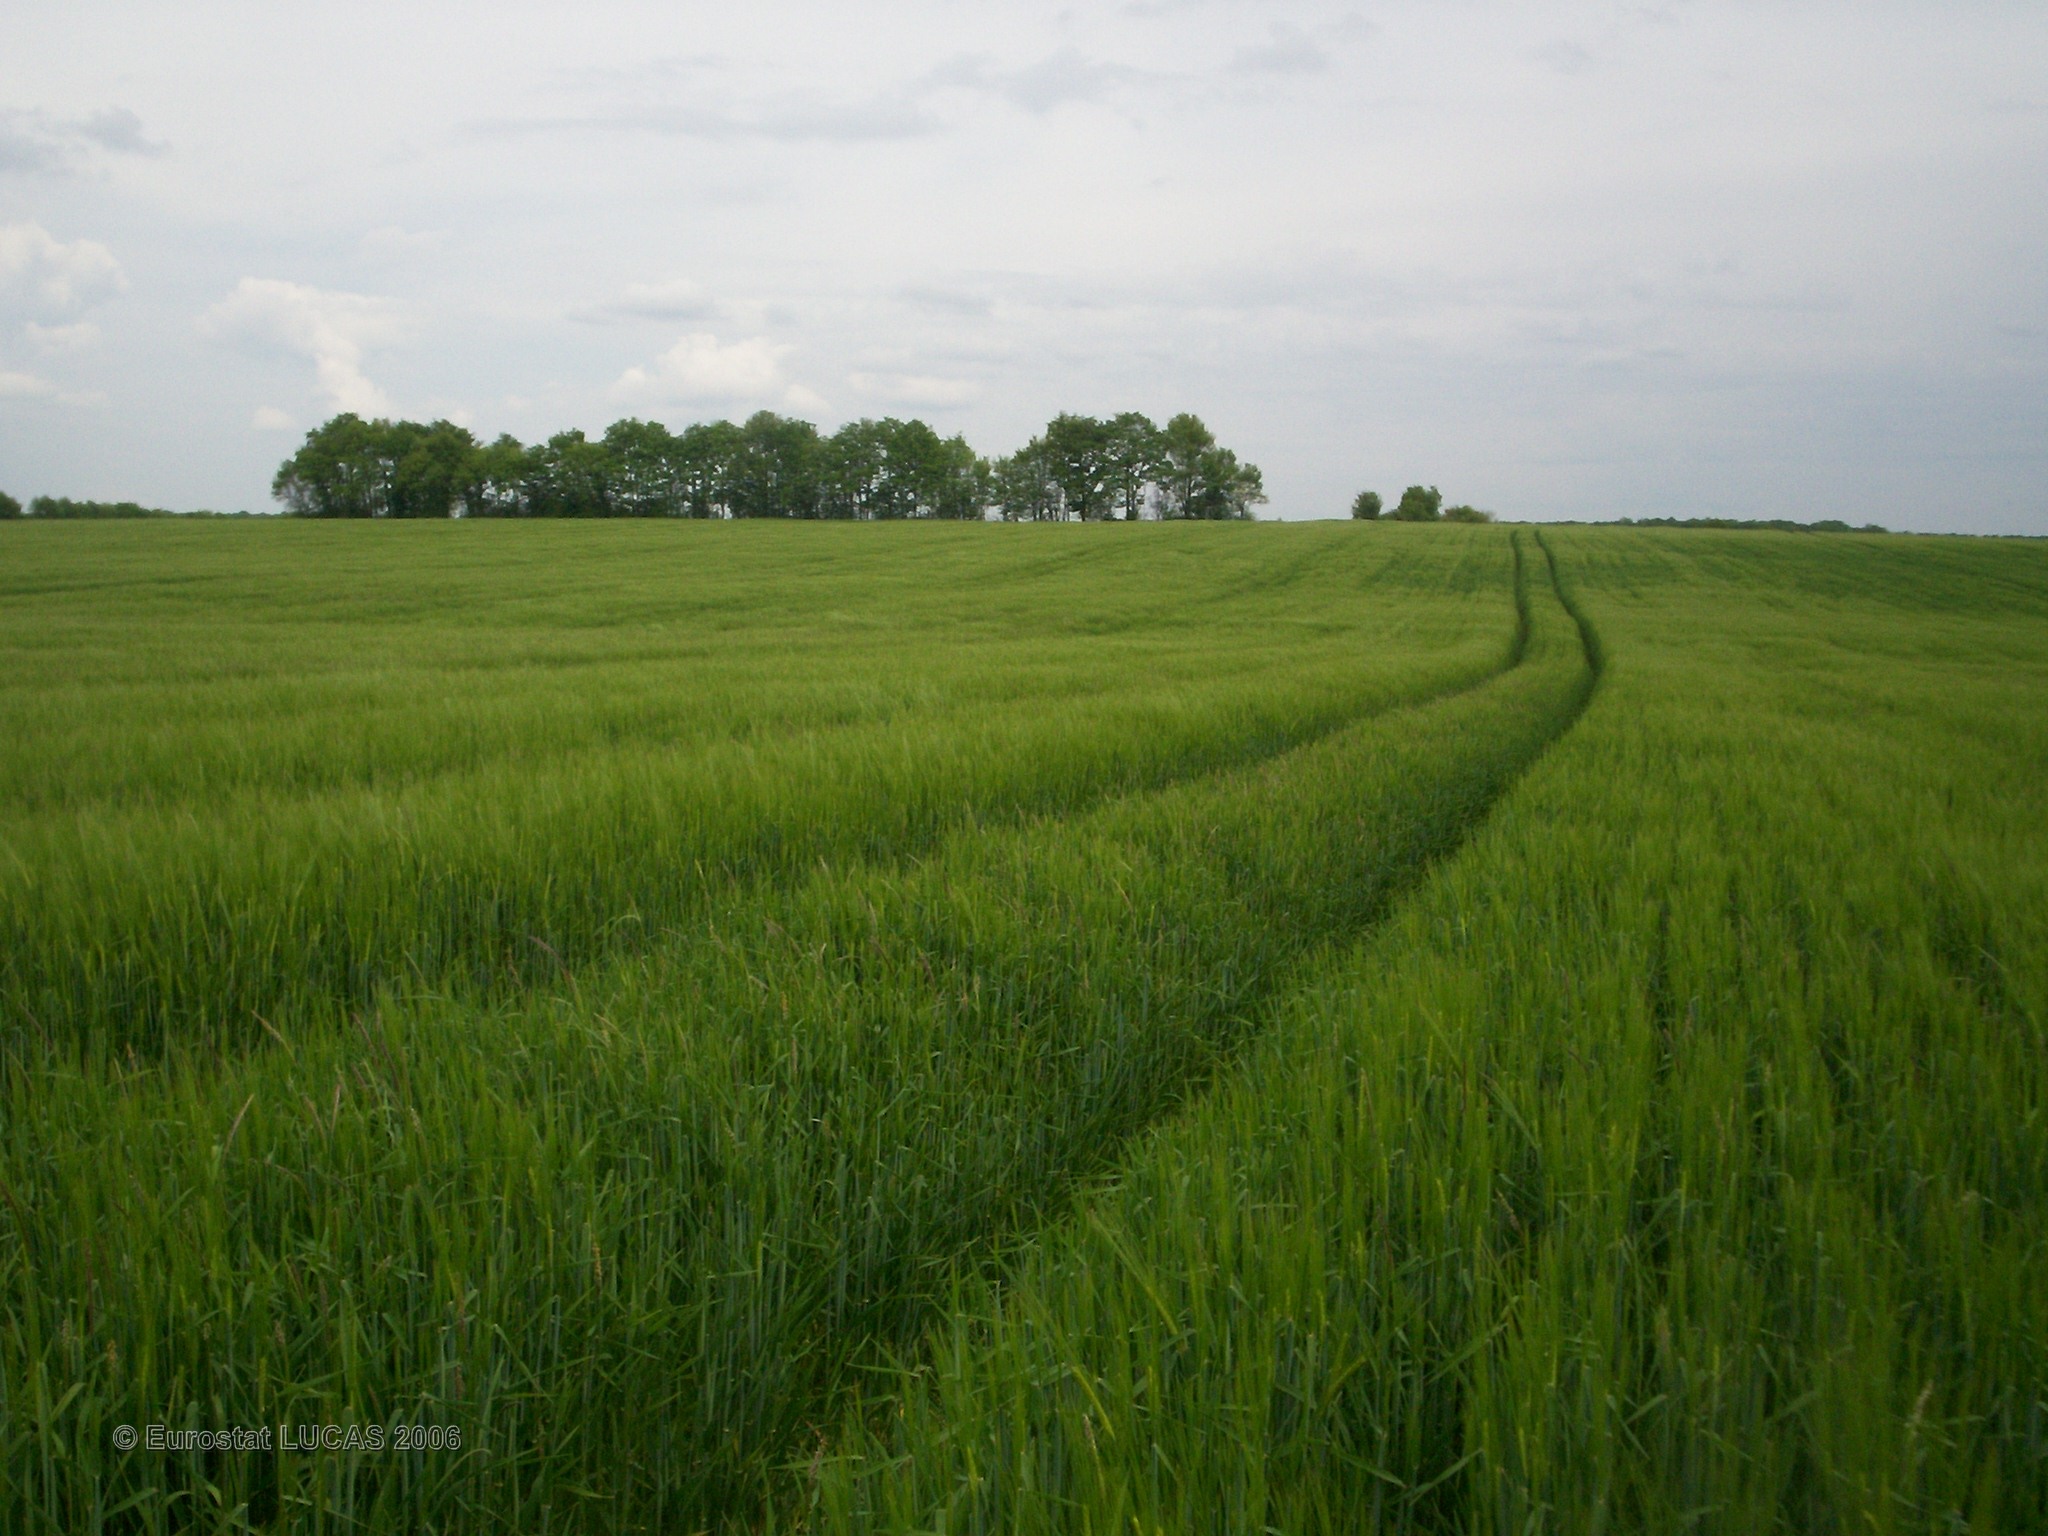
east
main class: Cropland
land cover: Barley
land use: Agriculture (excluding fallow land and kitchen gardens)
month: May
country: FR
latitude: 47.7134
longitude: 3.0226
